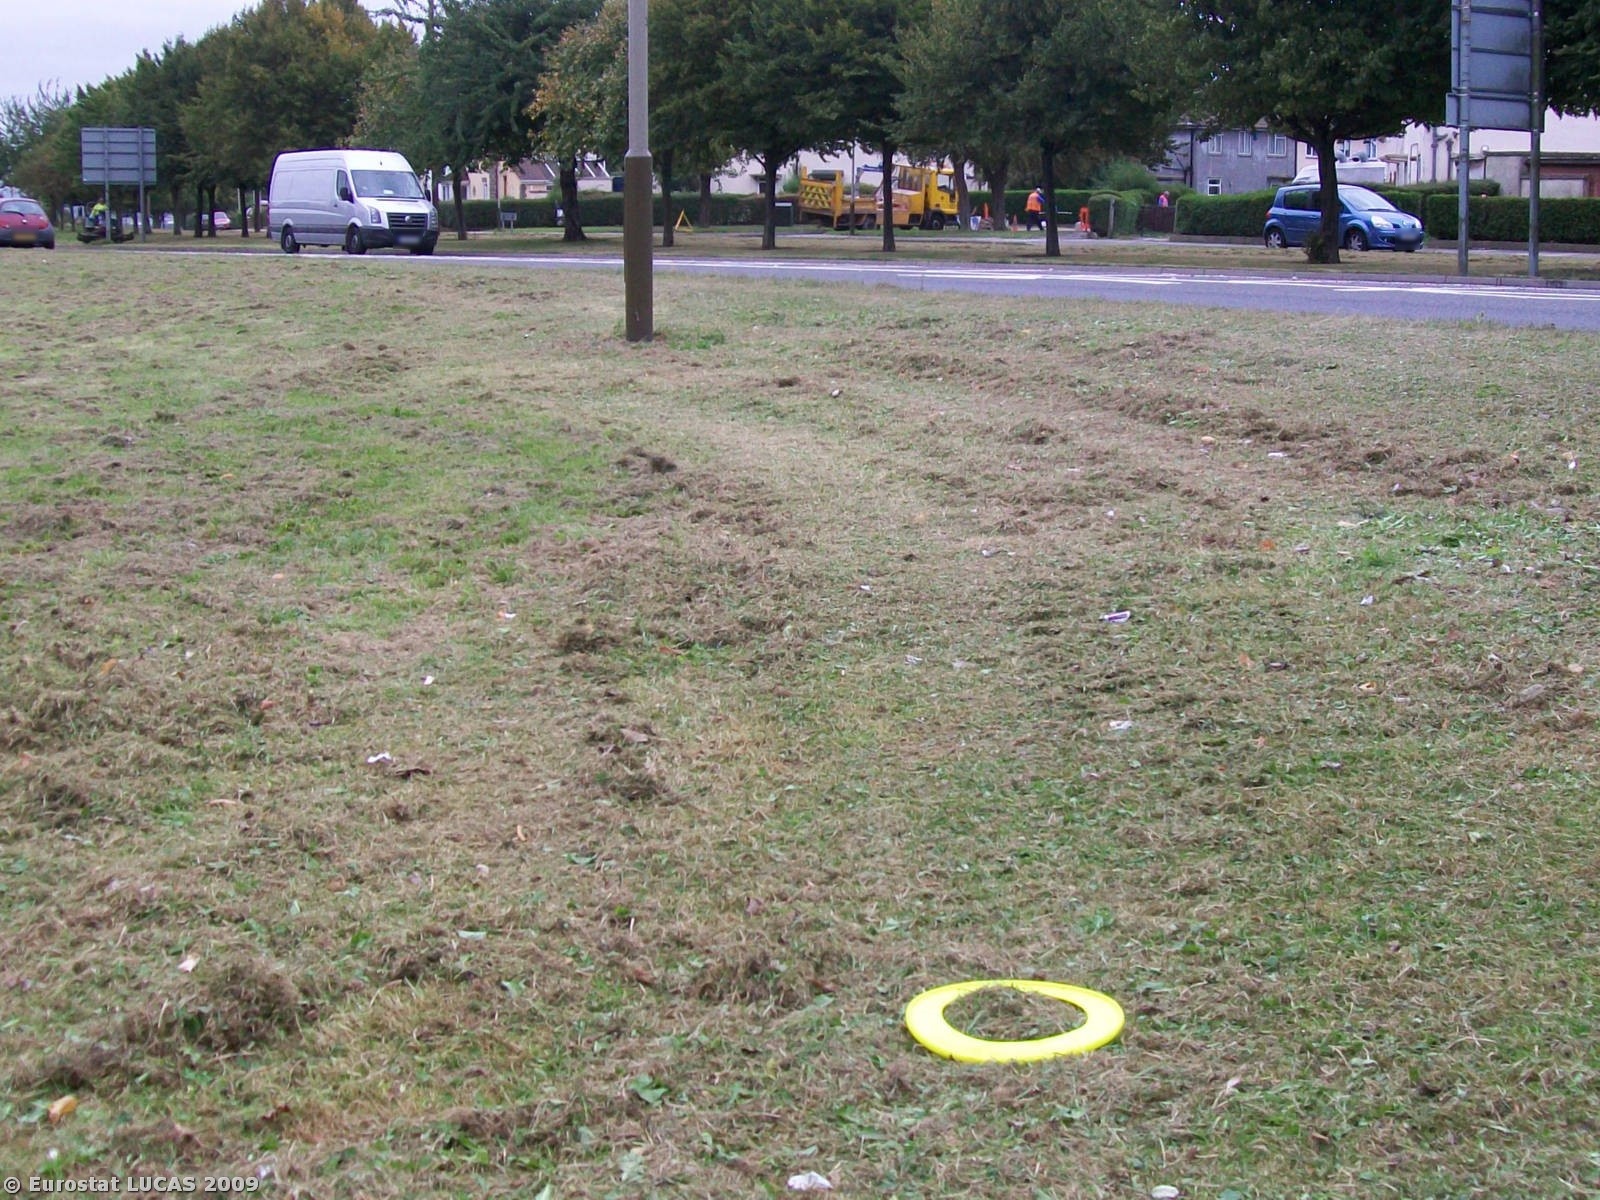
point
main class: Grassland
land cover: Grassland with sparse tree/shrub cover
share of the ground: > 75 %
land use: Unused
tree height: > 5 m
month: September
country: GB
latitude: 52.6672
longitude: -1.1511
